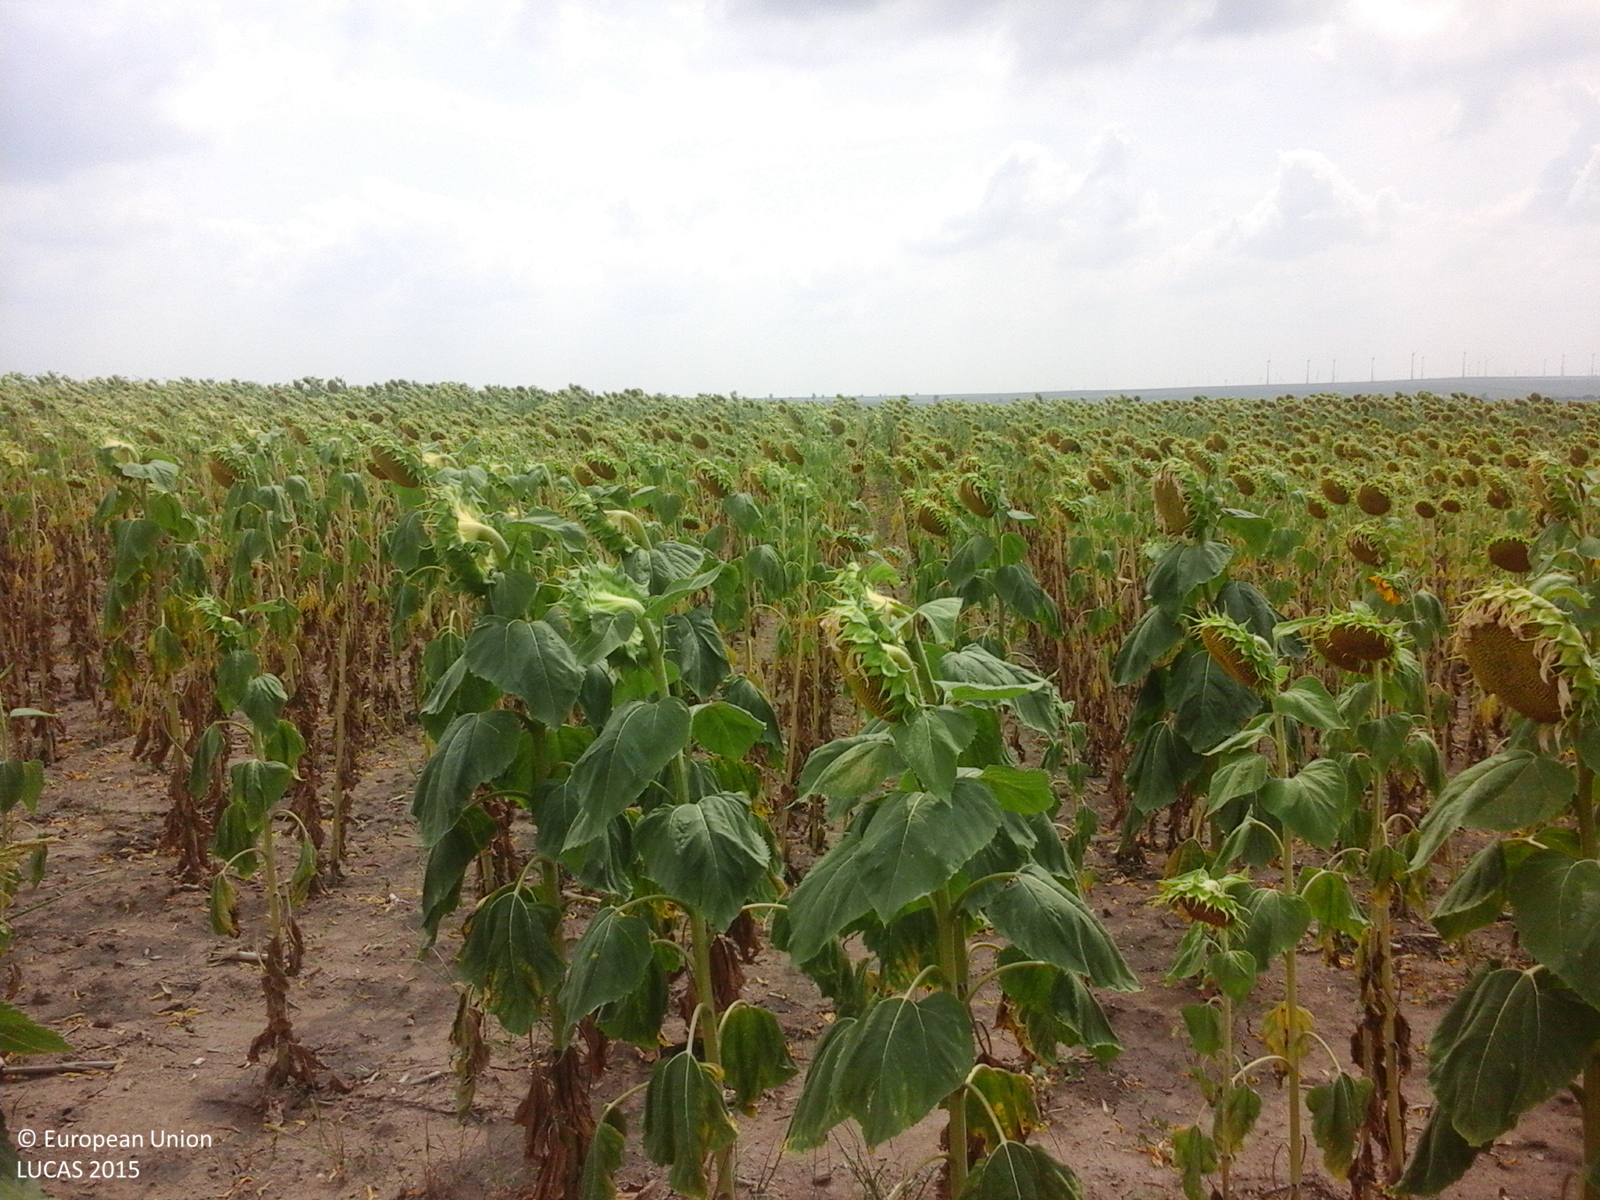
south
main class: Cropland
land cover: Sunflower
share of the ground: > 75 %
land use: Agriculture (excluding fallow land and kitchen gardens)
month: July
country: RO
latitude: 44.8815
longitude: 28.3137
